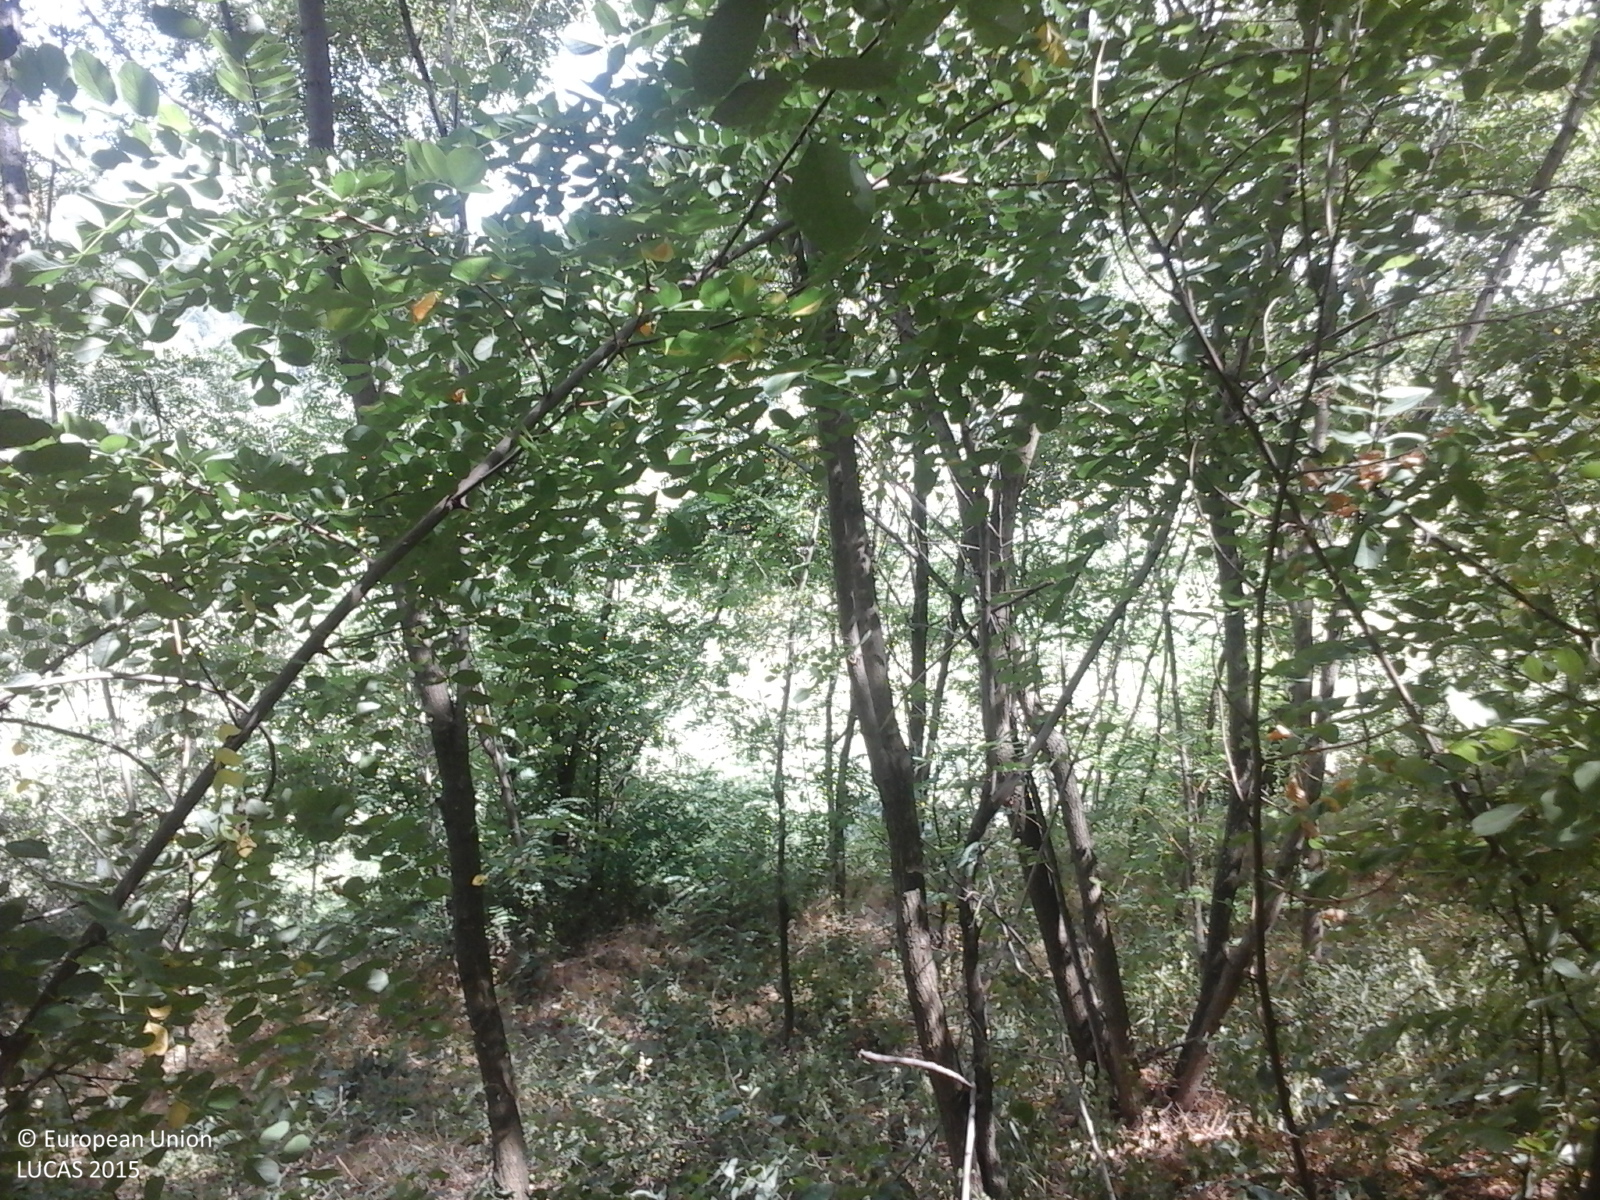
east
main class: Woodland
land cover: Broadleaved woodland
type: exotic forest
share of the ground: > 75 %
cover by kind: broadleaved forest trees 100 %
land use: Forestry
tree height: > 5 m
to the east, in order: Broadleaved woodland; Vineyards; Fences; Grass margins; Tracks; Shruby margins; Maize; Electric lines; Maize; Grass margins; Tracks; Grass margins; Maize; Lucerne; Common wheat
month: July
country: RO
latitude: 46.5420
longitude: 27.3322
